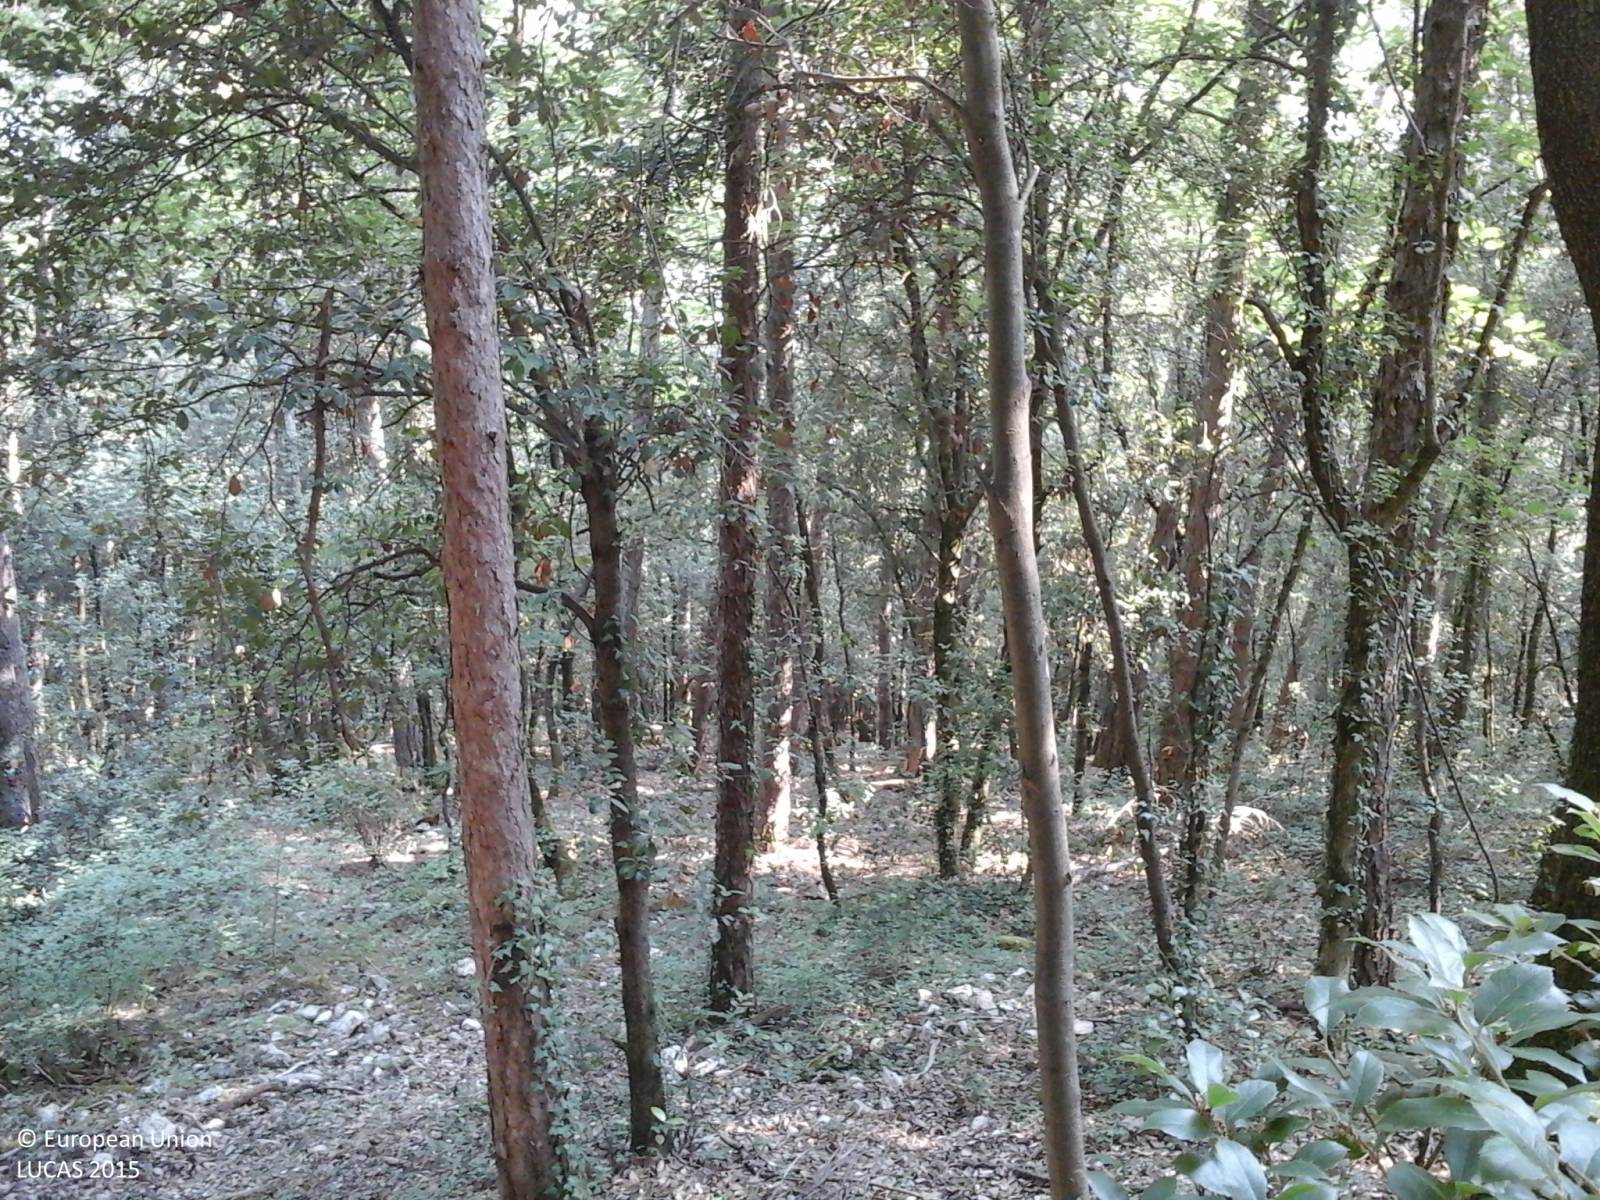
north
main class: Woodland
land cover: Other mixed woodland
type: coniferous forest of the mediterranean region
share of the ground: > 75 %
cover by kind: coniferous forest trees 60 %, broadleaved forest trees 40 %
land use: Forestry
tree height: > 5 m
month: July
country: IT
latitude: 42.3447
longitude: 13.3757
